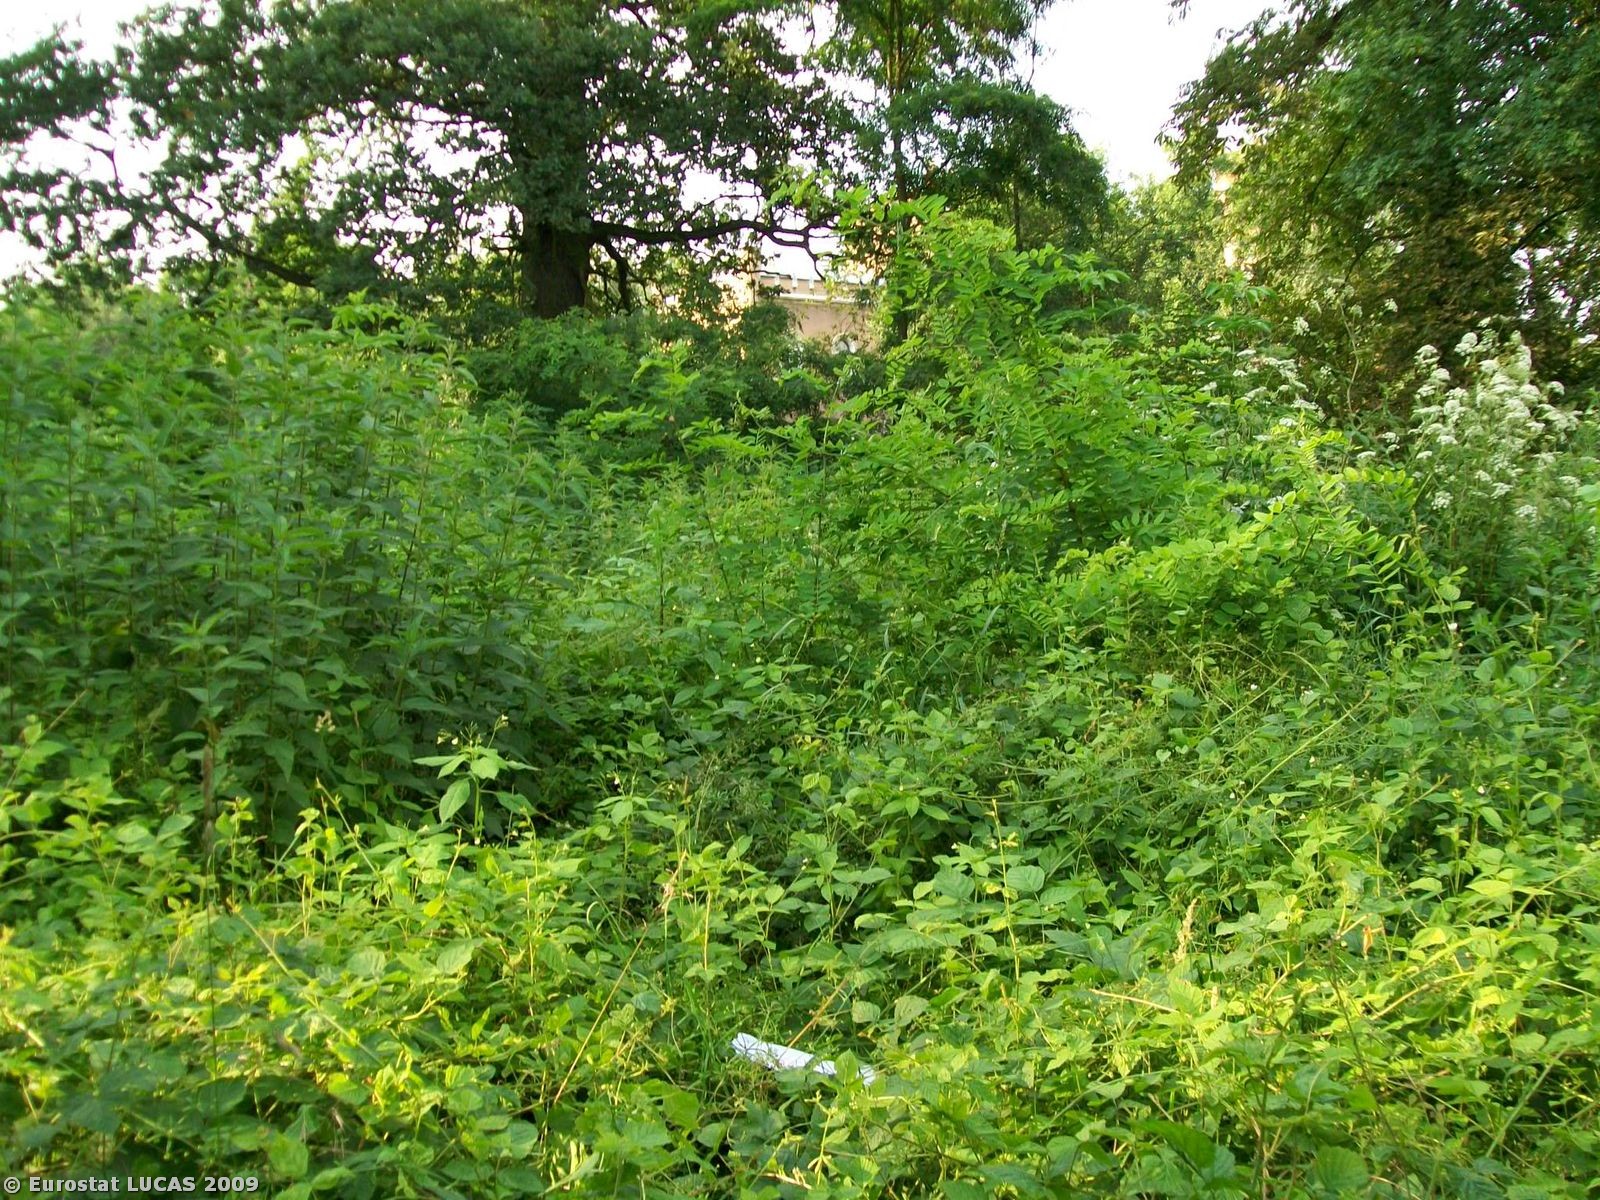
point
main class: Shrubland
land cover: Shrubland with sparse tree cover
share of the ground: > 75 %
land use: Unused
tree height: > 5 m
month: July
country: PL
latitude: 51.1976
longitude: 16.9794
